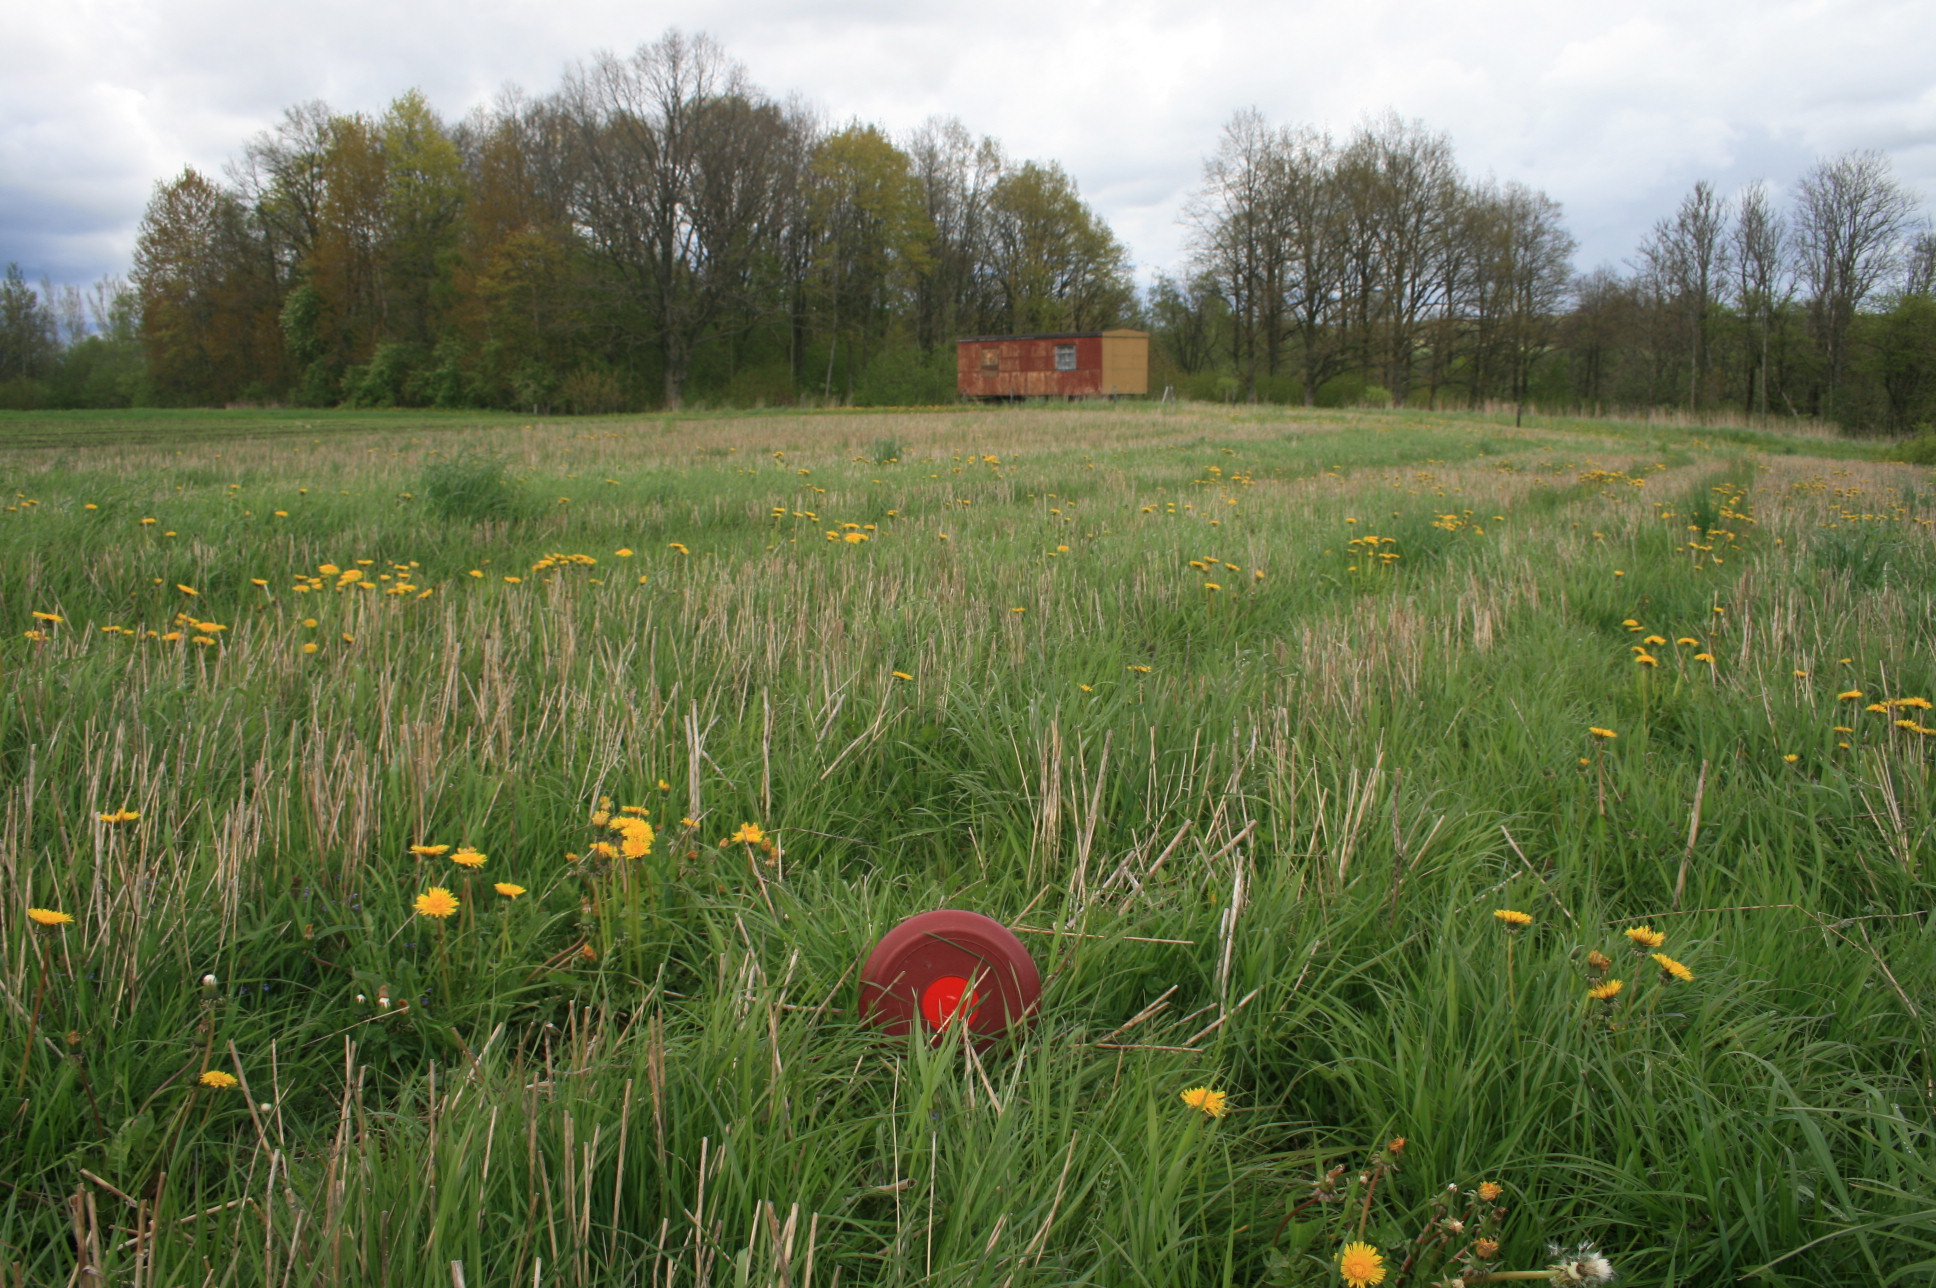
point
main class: Grassland
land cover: Grassland without tree/shrub cover
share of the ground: > 75 %
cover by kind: herbaceous plants 100 %
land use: Agriculture (excluding fallow land and kitchen gardens)
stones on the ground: < 10 %
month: May
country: LT
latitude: 56.2521
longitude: 22.0759
